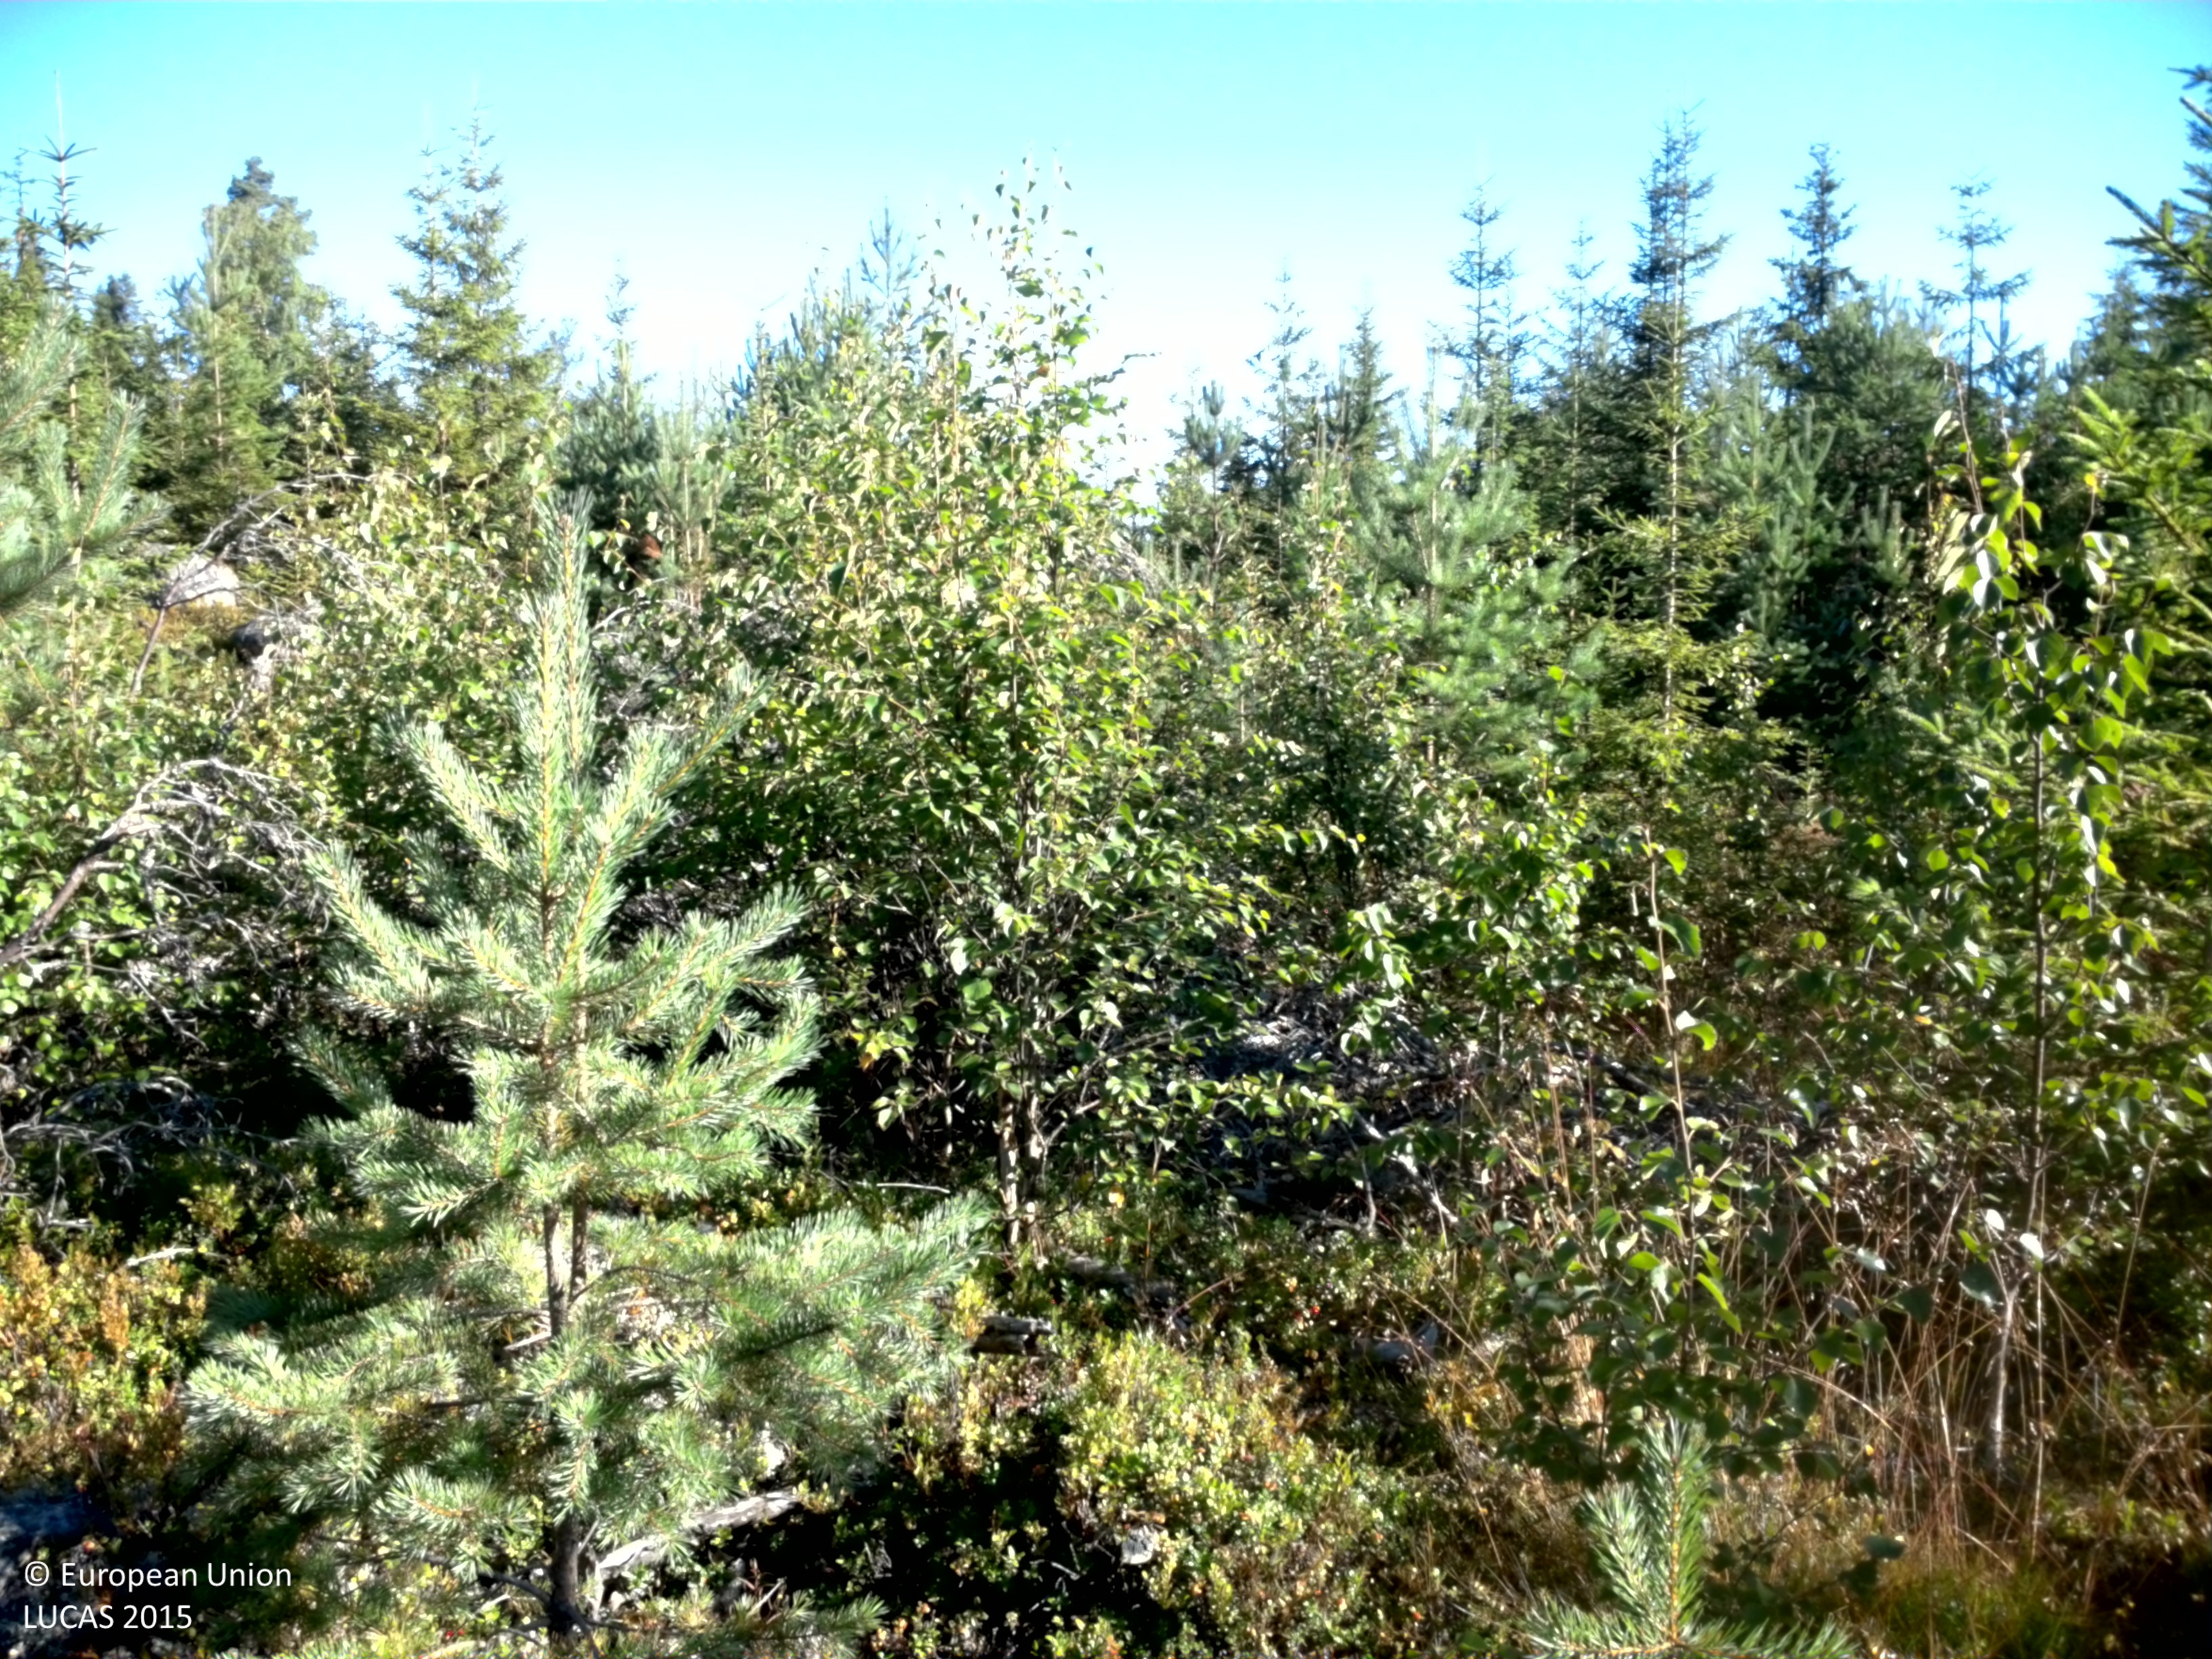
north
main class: Woodland
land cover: Other mixed woodland
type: boreal forest
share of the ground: 50 - 75 %
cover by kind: coniferous forest trees 40 %, broadleaved forest trees 25 %, shrubs 25 %, lichens and mosses 10 %
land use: Forestry
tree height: < 5 m
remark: Clear cut
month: August
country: SE
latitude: 60.0310
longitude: 14.0998
